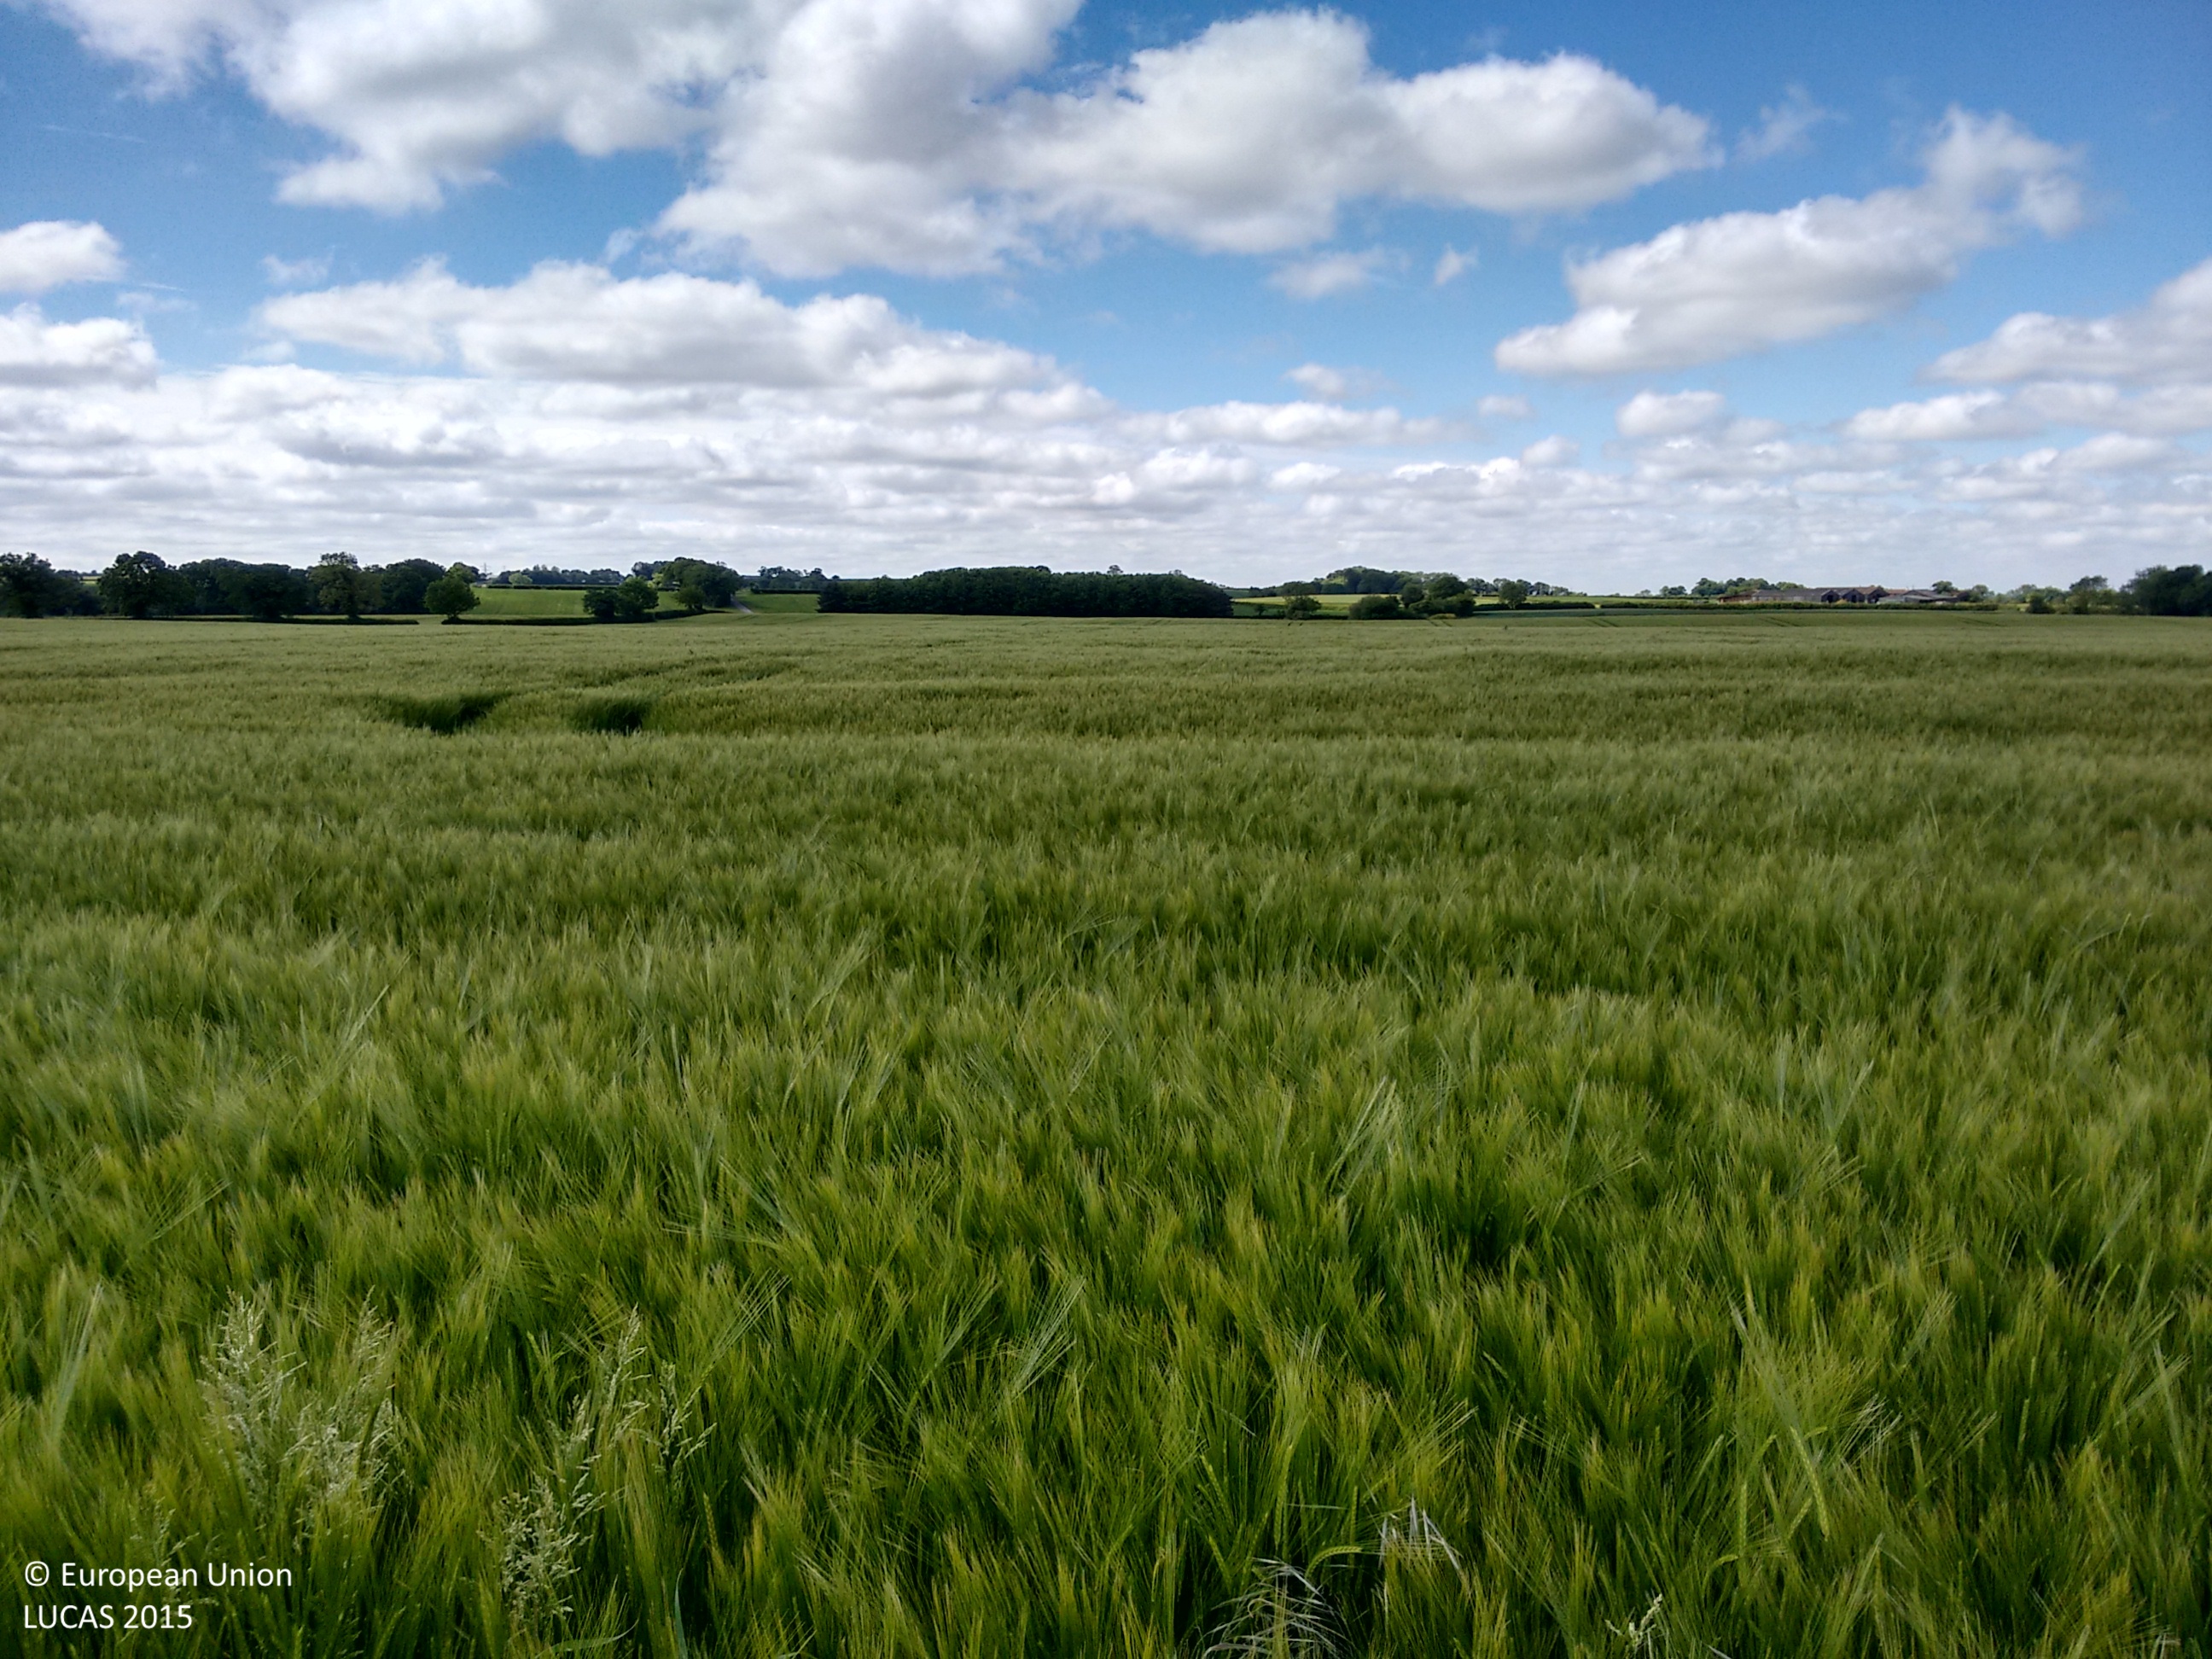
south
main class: Cropland
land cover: Barley
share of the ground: > 75 %
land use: Agriculture (excluding fallow land and kitchen gardens)
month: June
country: GB
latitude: 54.1117
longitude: -1.0413
